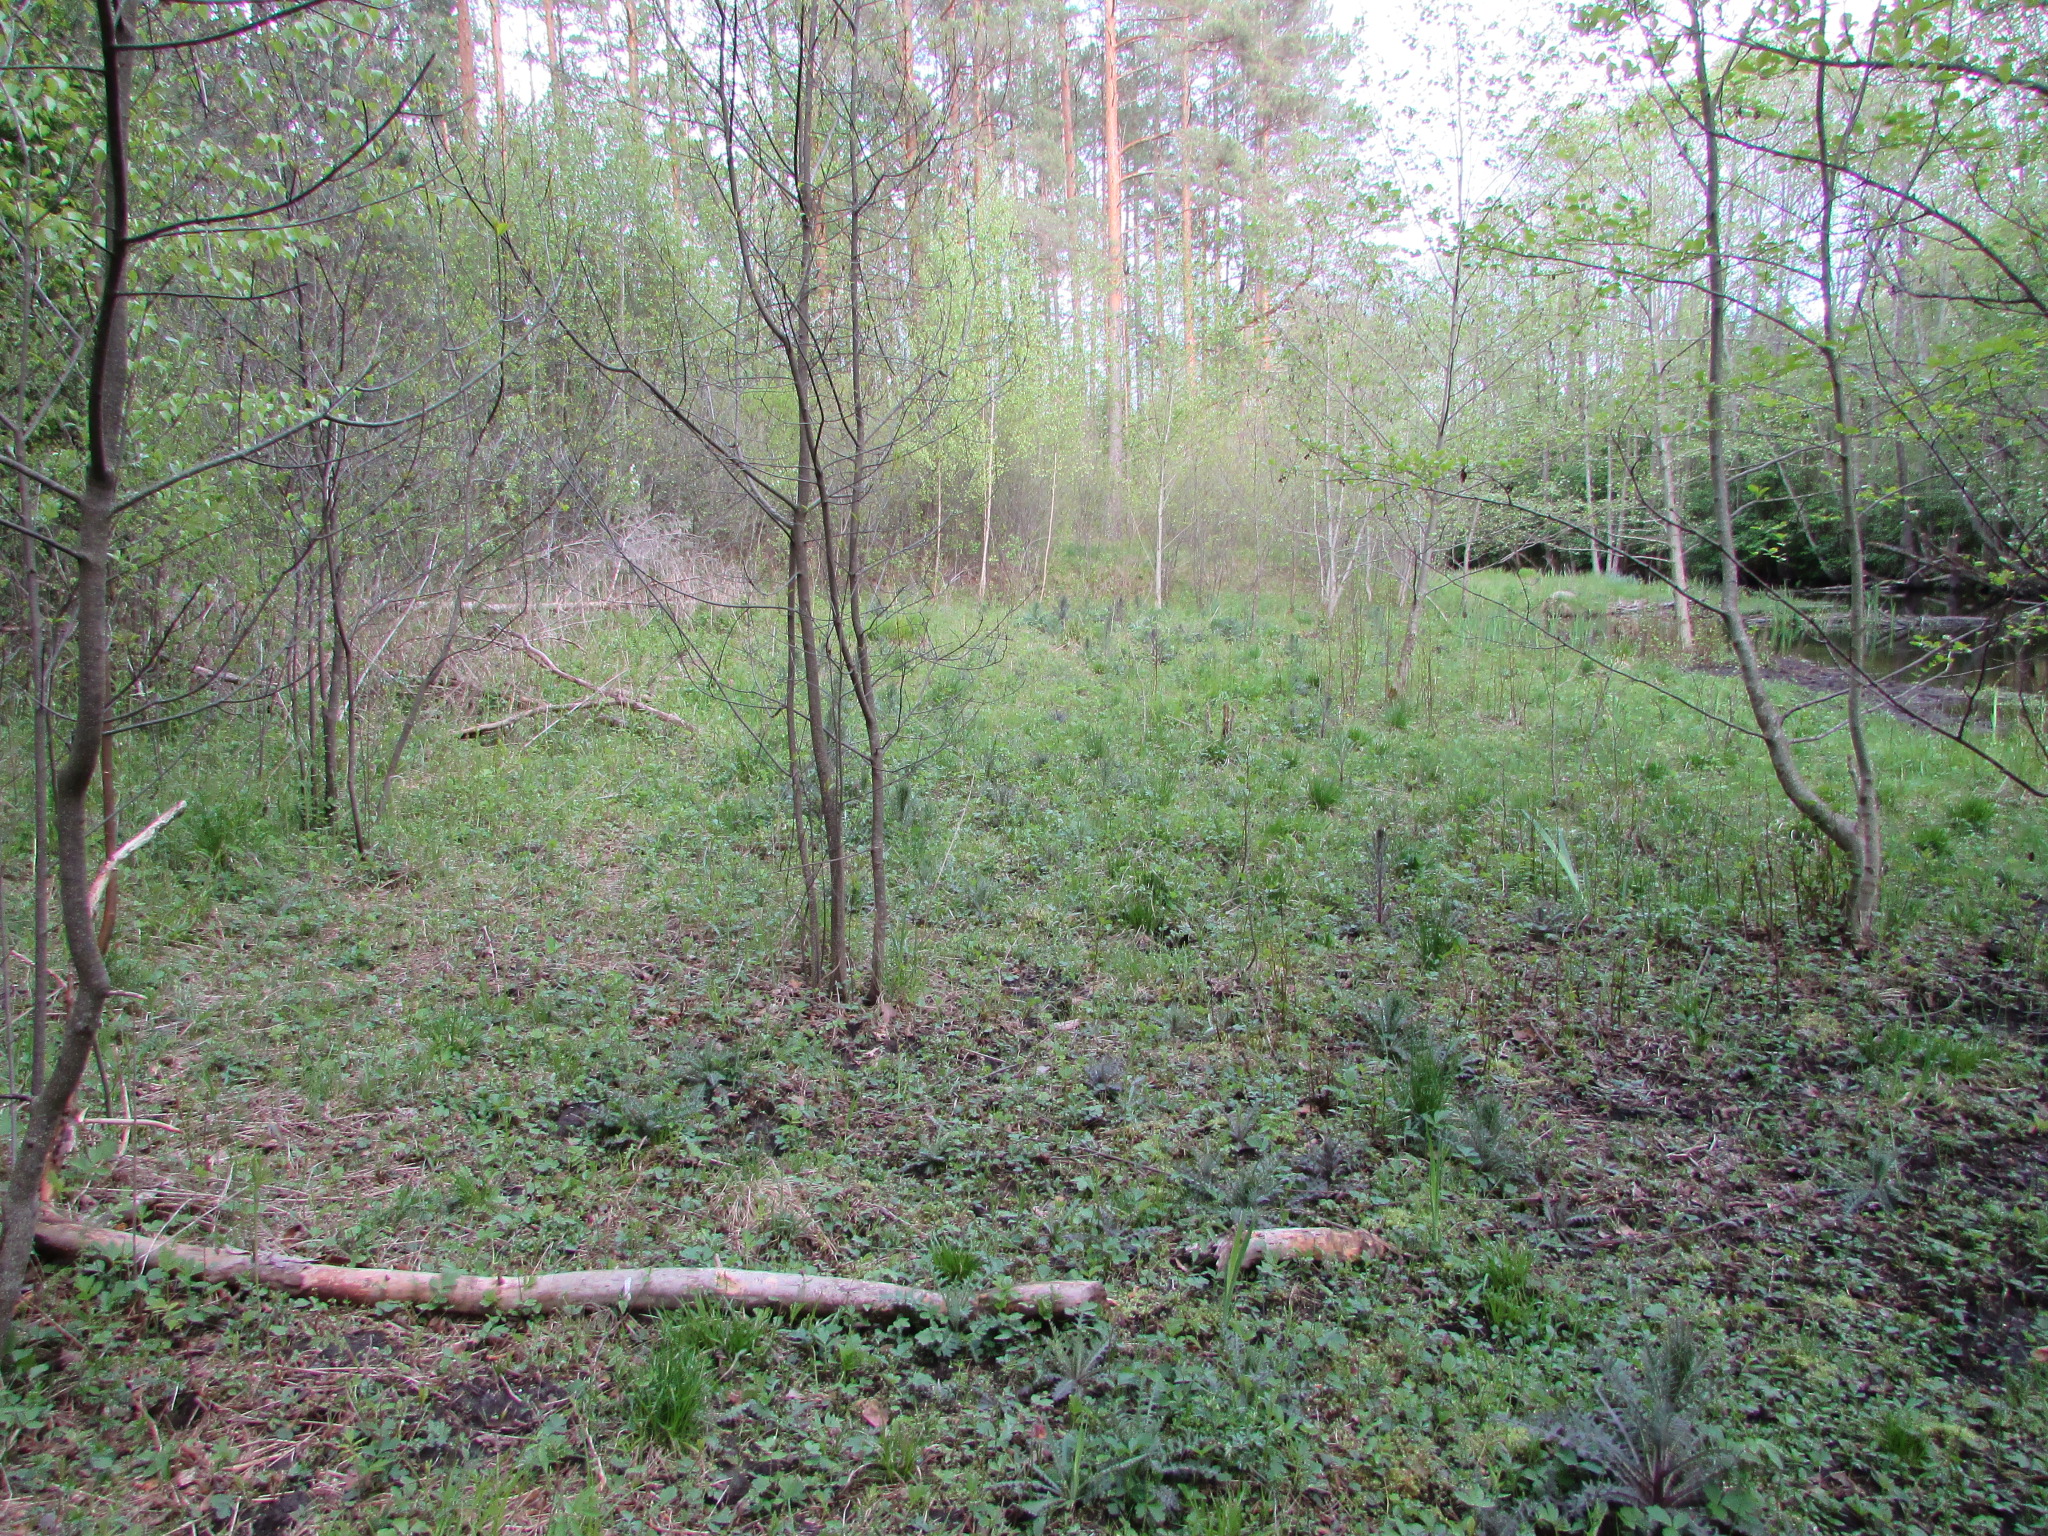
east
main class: Woodland
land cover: Pine dominated mixed woodland
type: hemiboreal forest and nemoral coniferous forest and mixed broadleaved-coniferous forest
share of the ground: > 75 %
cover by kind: coniferous forest trees 60 %, broadleaved forest trees 40 %
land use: Forestry
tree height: > 5 m
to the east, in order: Pine dominated mixed woodland; Spontaneously vegetated surfaces; Inland fresh running water; Grassland with sparse tree/shrub cover; Broadleaved woodland; Inland fresh running water; Broadleaved woodland; Electric lines; Grassland without tree/shrub cover; Broadleaved woodland
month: May
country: LV
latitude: 56.1402
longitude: 27.1809
